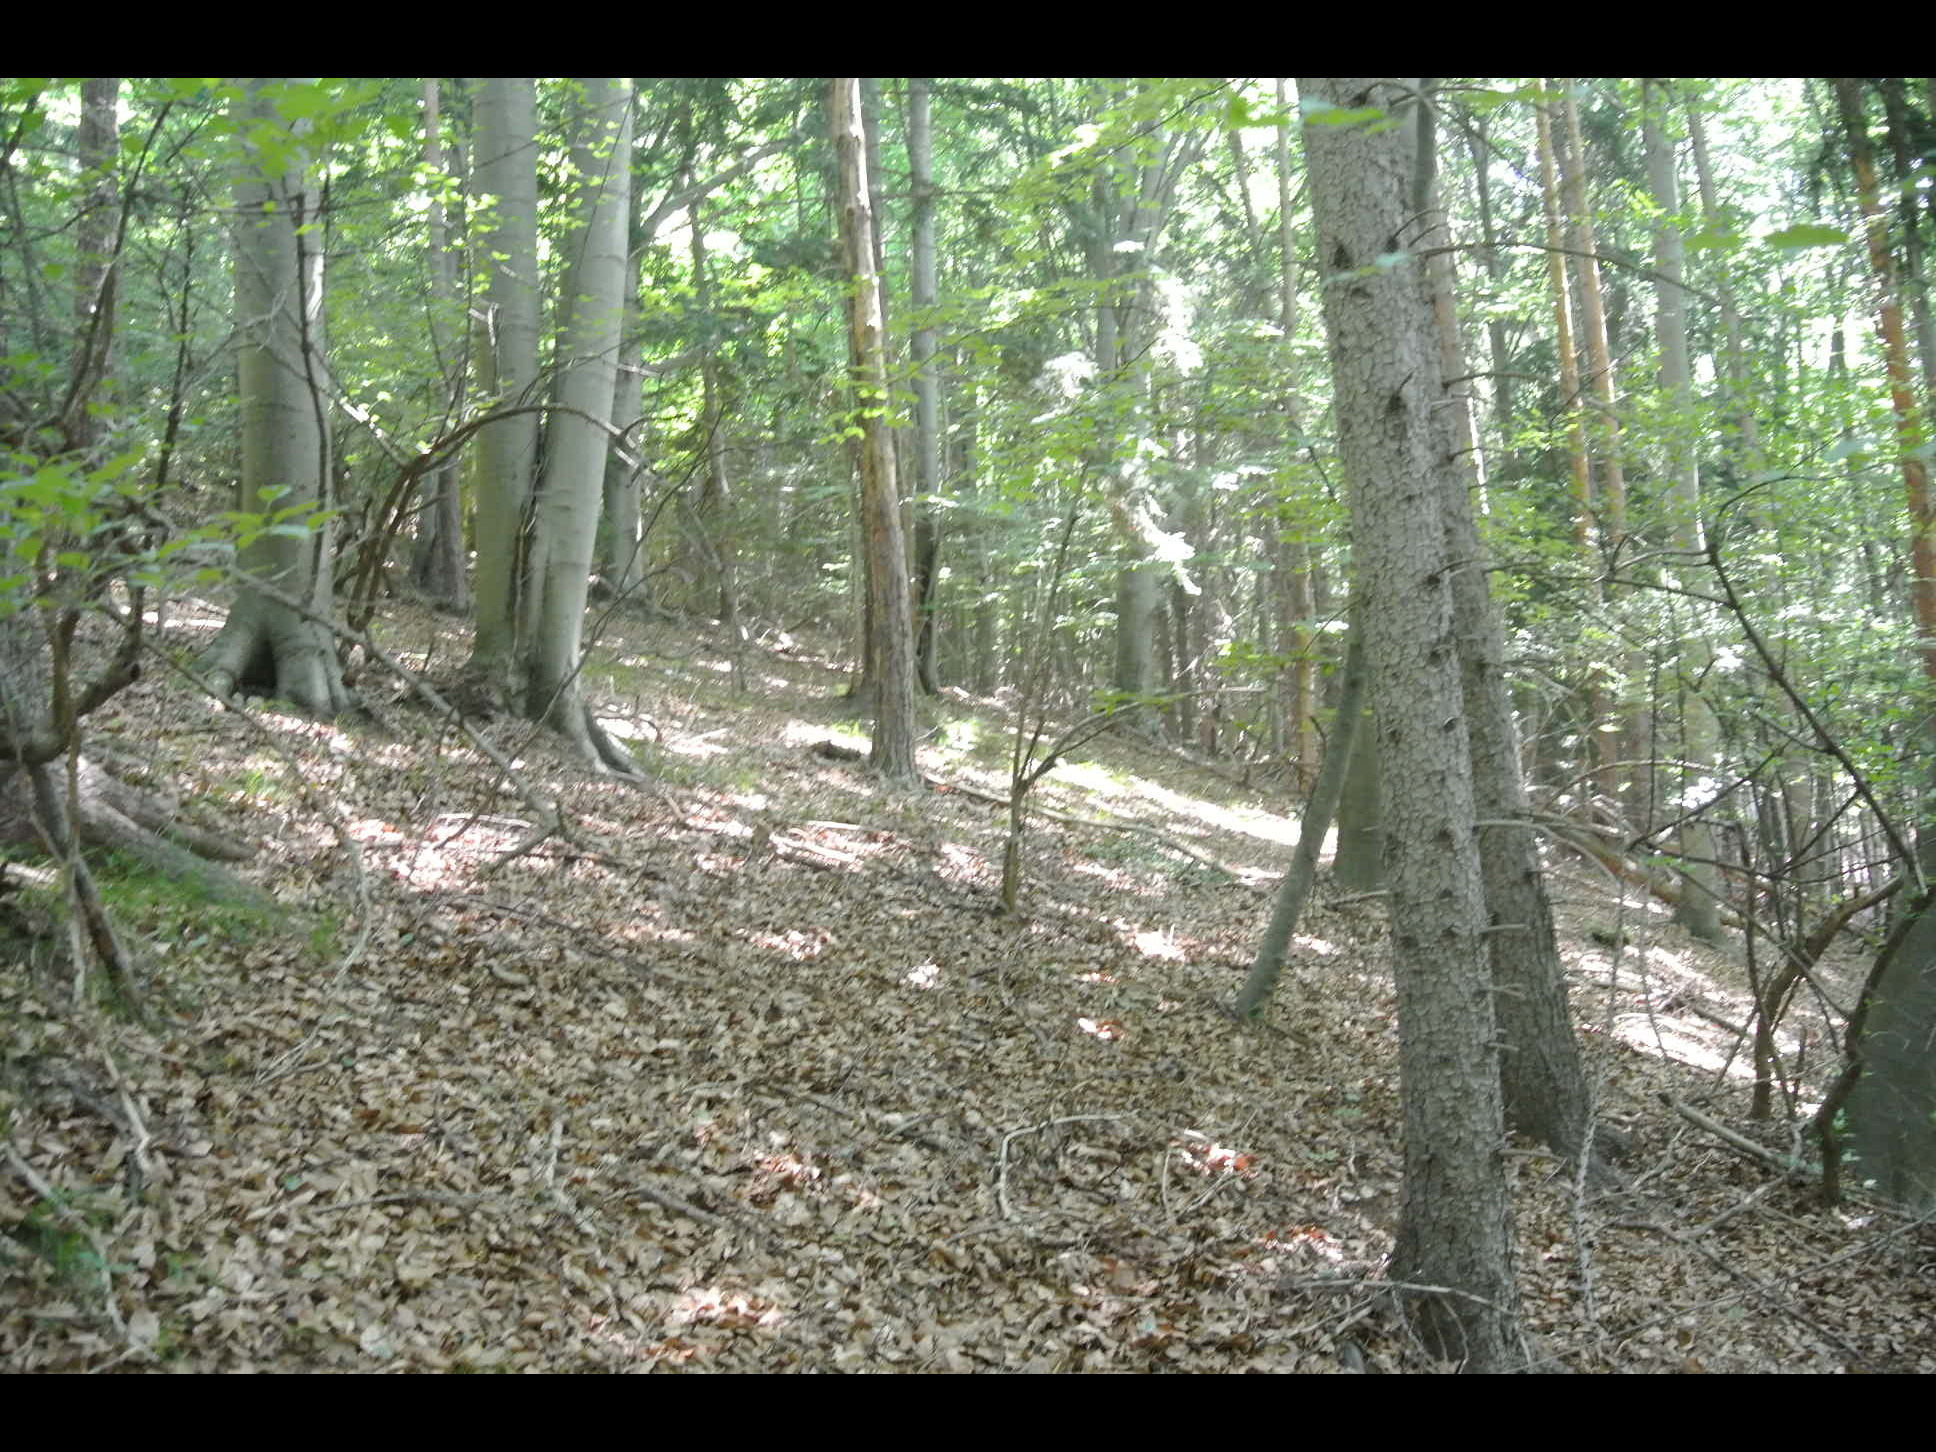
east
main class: Woodland
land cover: Spruce dominated mixed woodland
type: alpine coniferous forest
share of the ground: > 75 %
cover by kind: broadleaved forest trees 60 %, coniferous forest trees 40 %
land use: Forestry
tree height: > 5 m
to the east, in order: Spruce dominated mixed woodland; Grassland without tree/shrub cover; Spruce dominated coniferous woodland
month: July
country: AT
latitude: 47.6538
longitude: 16.1675
